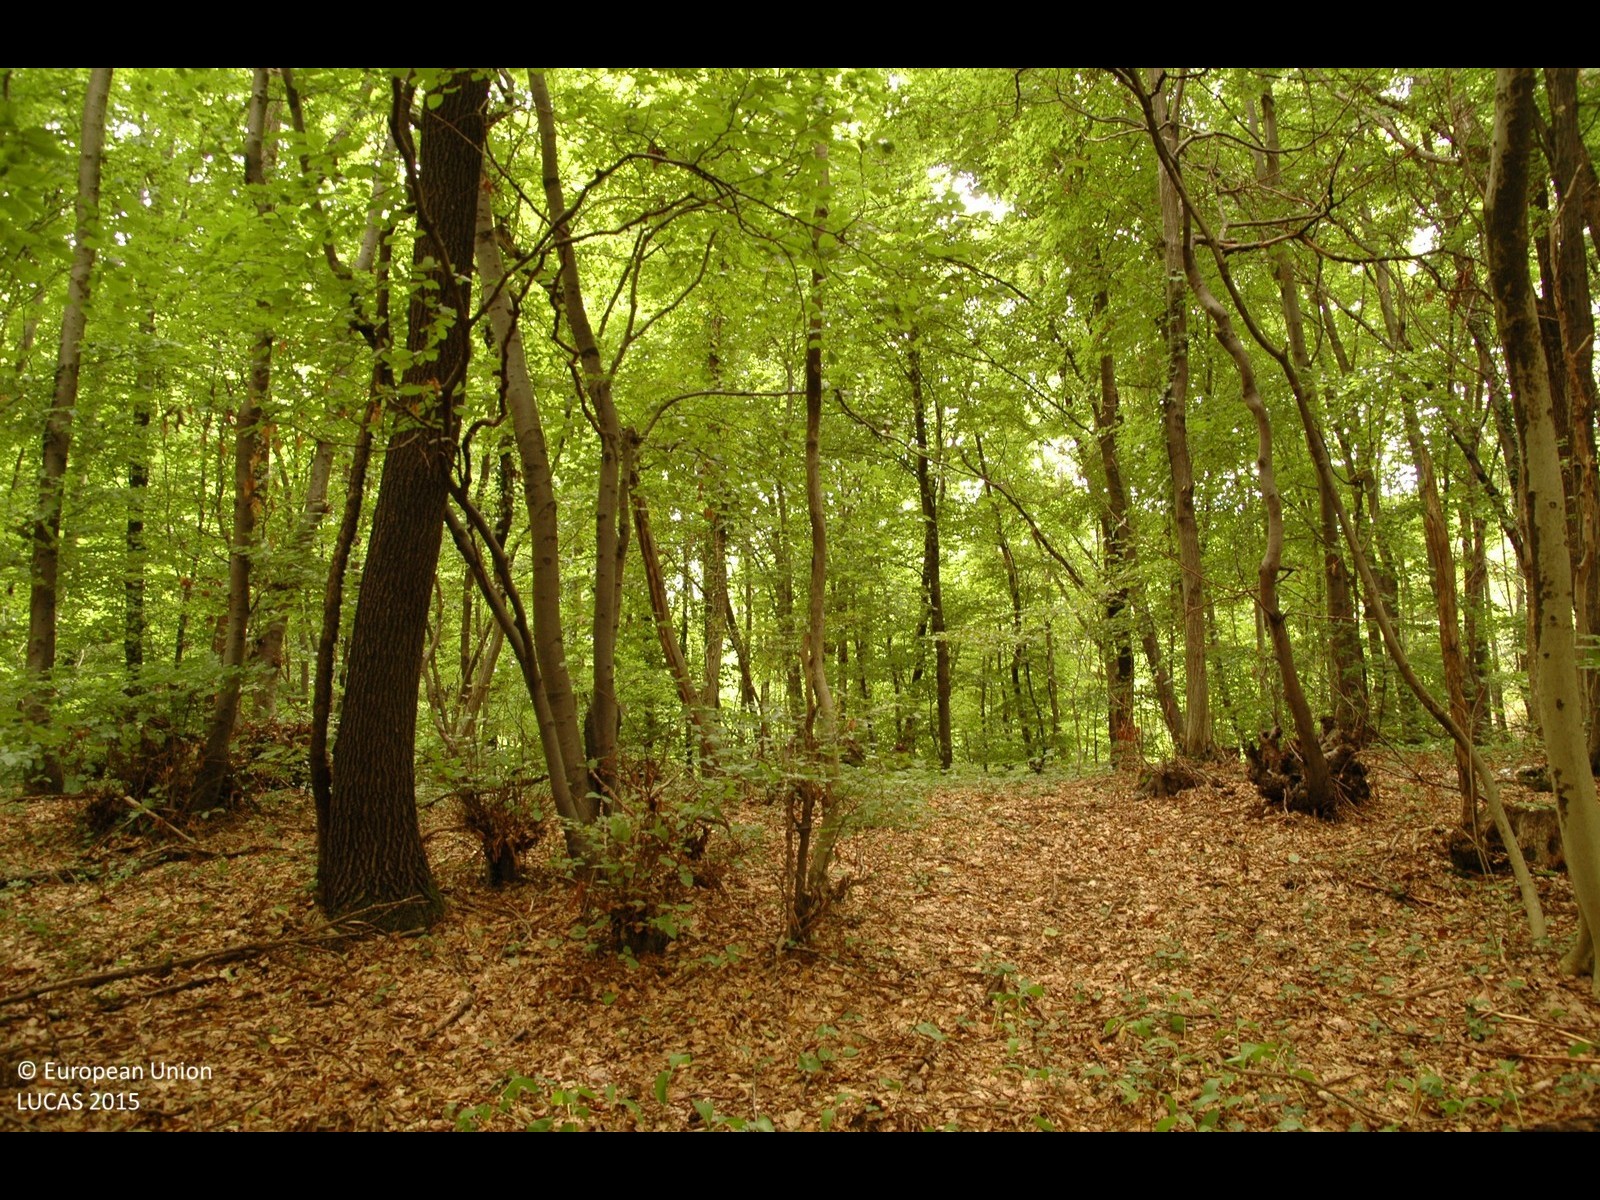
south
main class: Woodland
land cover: Broadleaved woodland
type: mesophytic deciduous forest
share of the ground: > 75 %
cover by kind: broadleaved forest trees 100 %
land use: Forestry
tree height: > 5 m
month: August
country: HR
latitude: 45.8884
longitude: 16.0937
